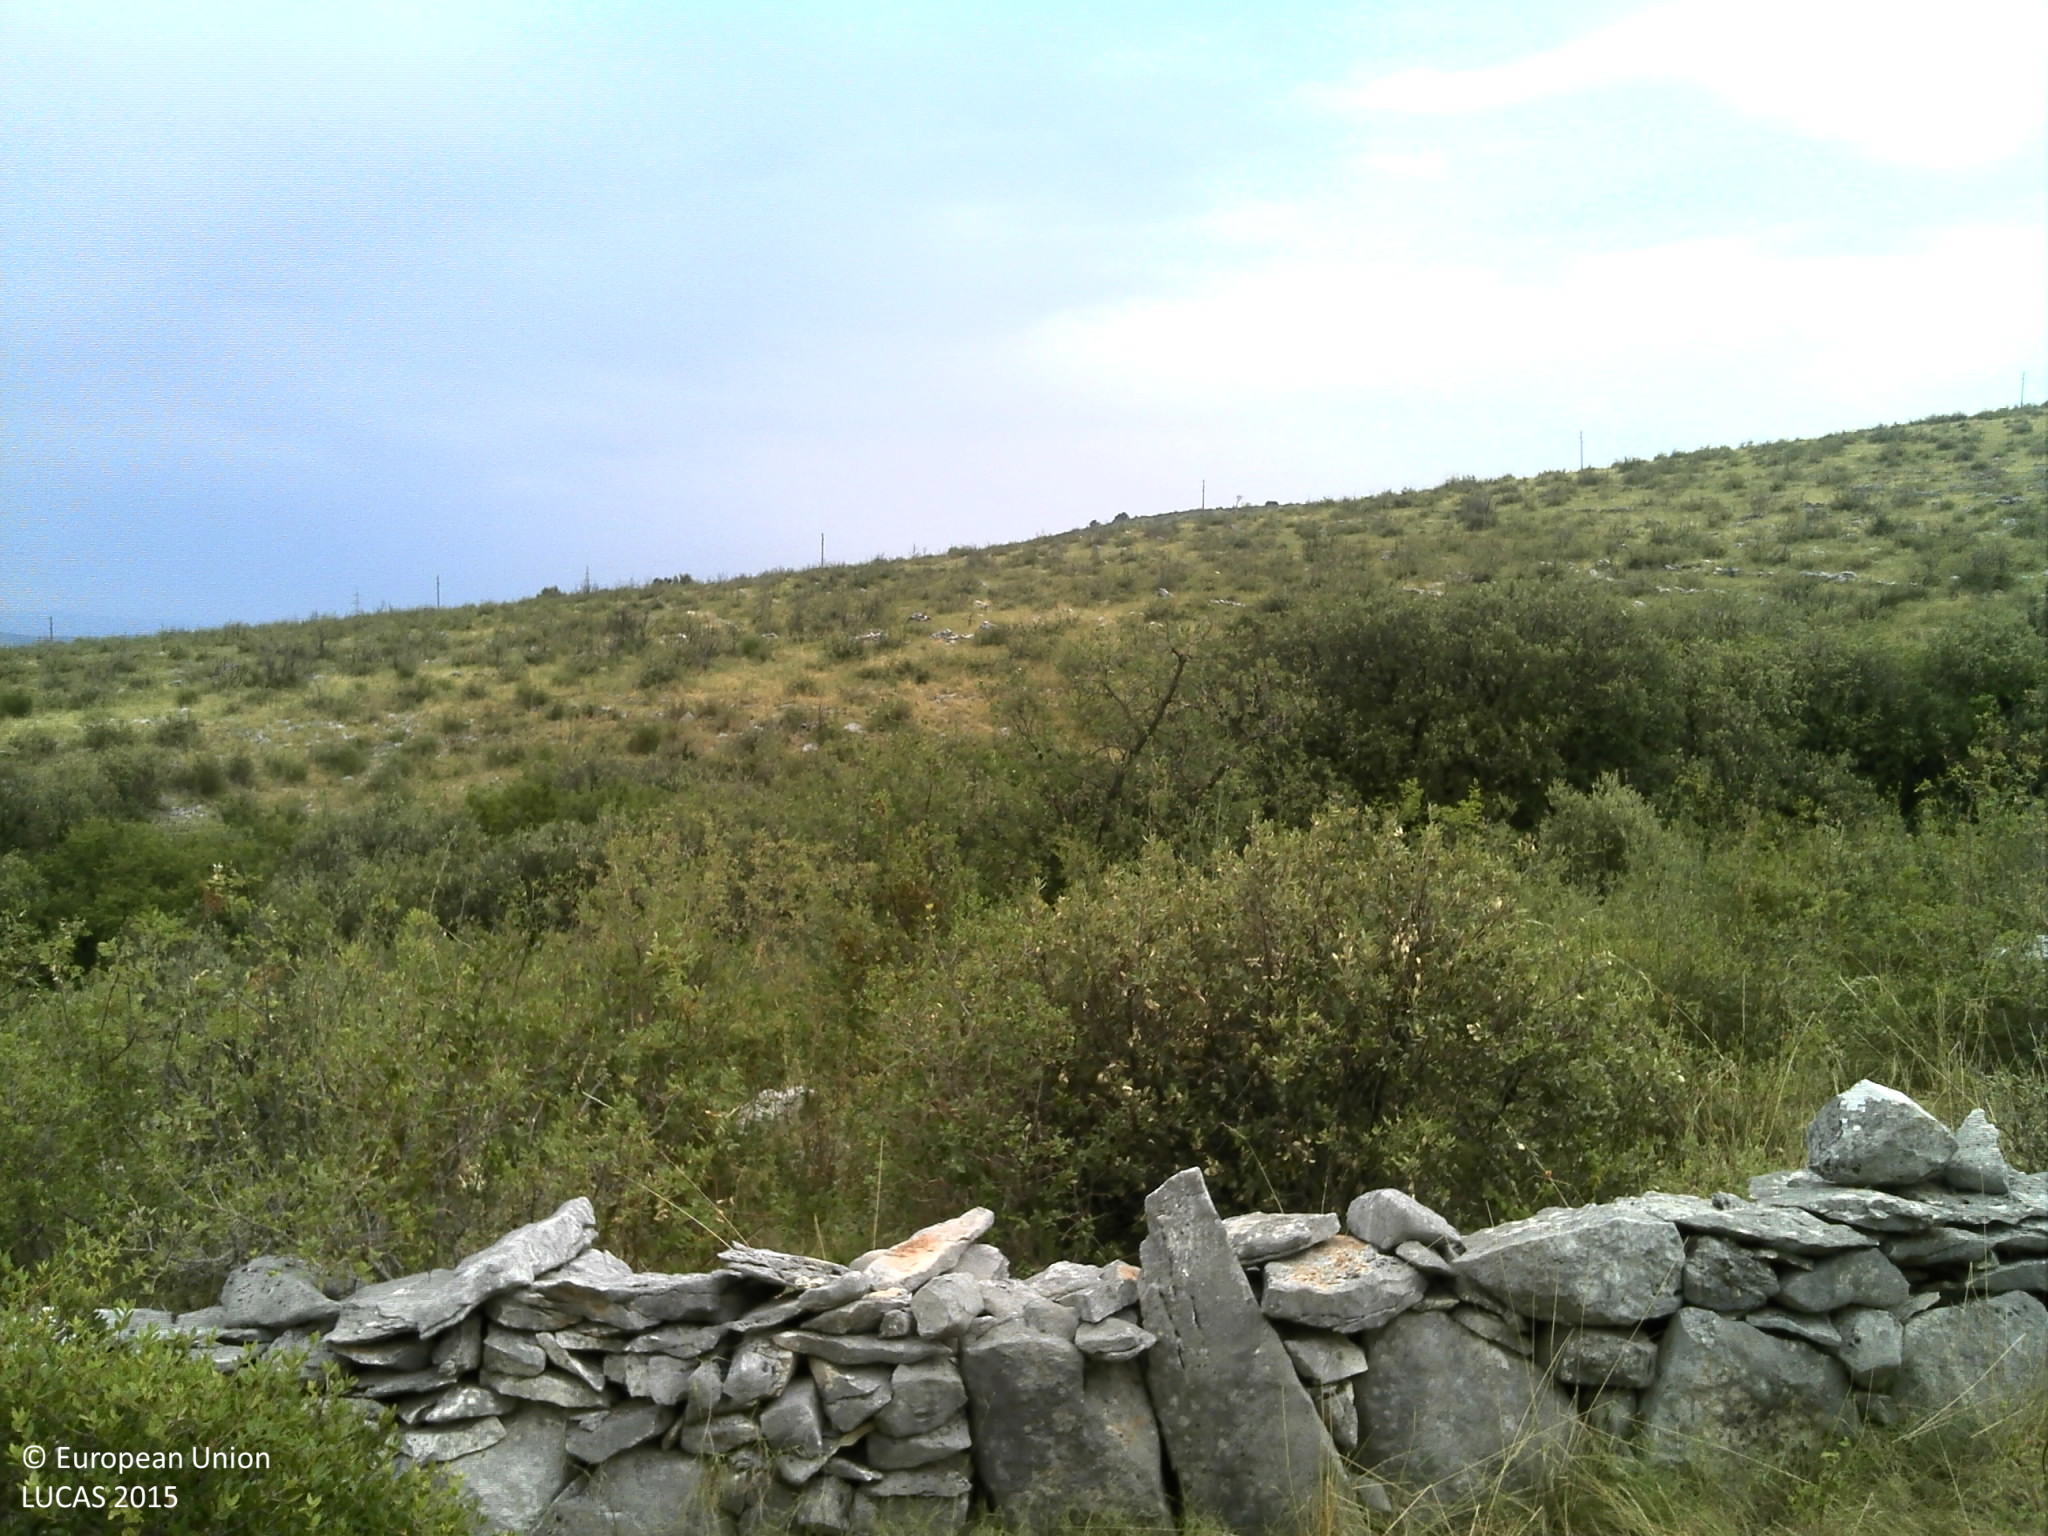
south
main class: Shrubland
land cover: Shrubland without tree cover
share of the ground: 50 - 75 %
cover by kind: shrubs 50 %, herbaceous plants 20 %, consolidated bare surface 15 %, unconsolidated bare surface 15 %
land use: Semi-natural and natural areas not in use
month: June
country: HR
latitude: 43.5461
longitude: 16.2658
